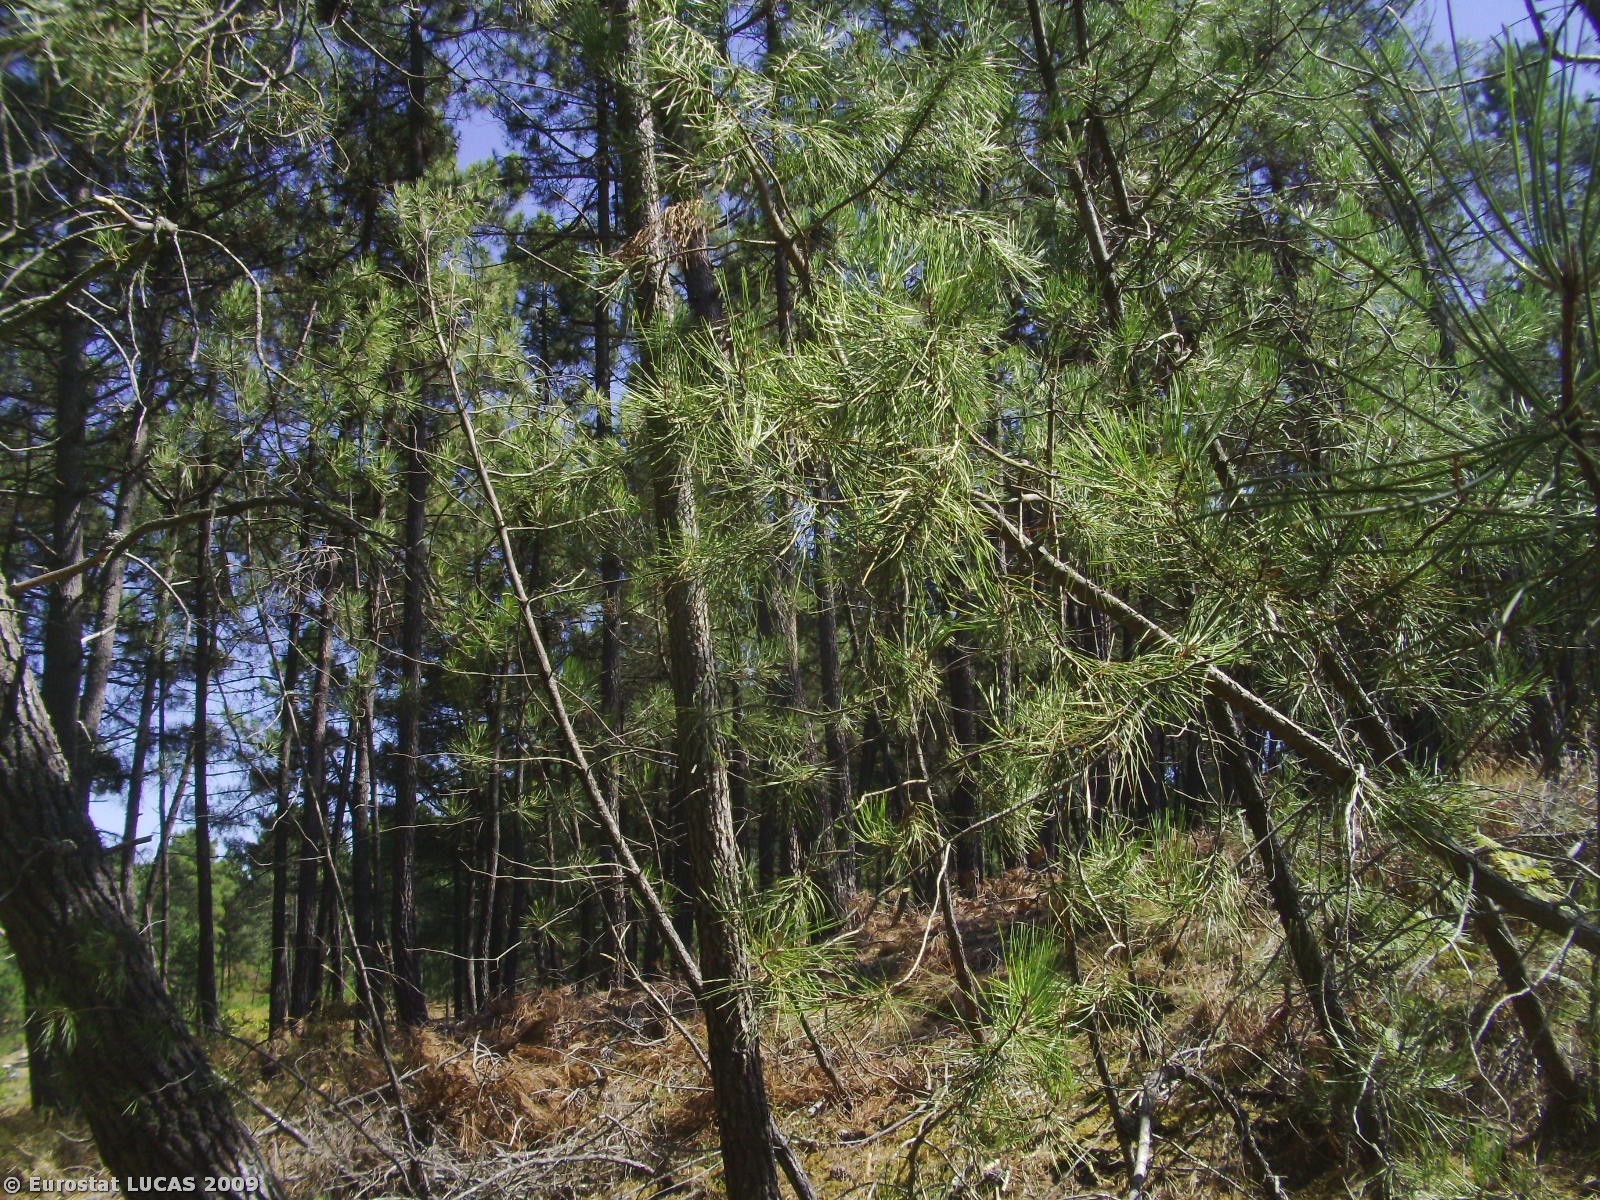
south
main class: Woodland
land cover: Coniferous woodland
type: coniferous forest of the mediterranean region
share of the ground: 50 - 75 %
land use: Forestry
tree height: > 5 m
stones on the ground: < 10 %
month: September
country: PT
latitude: 41.2538
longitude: -7.6592
